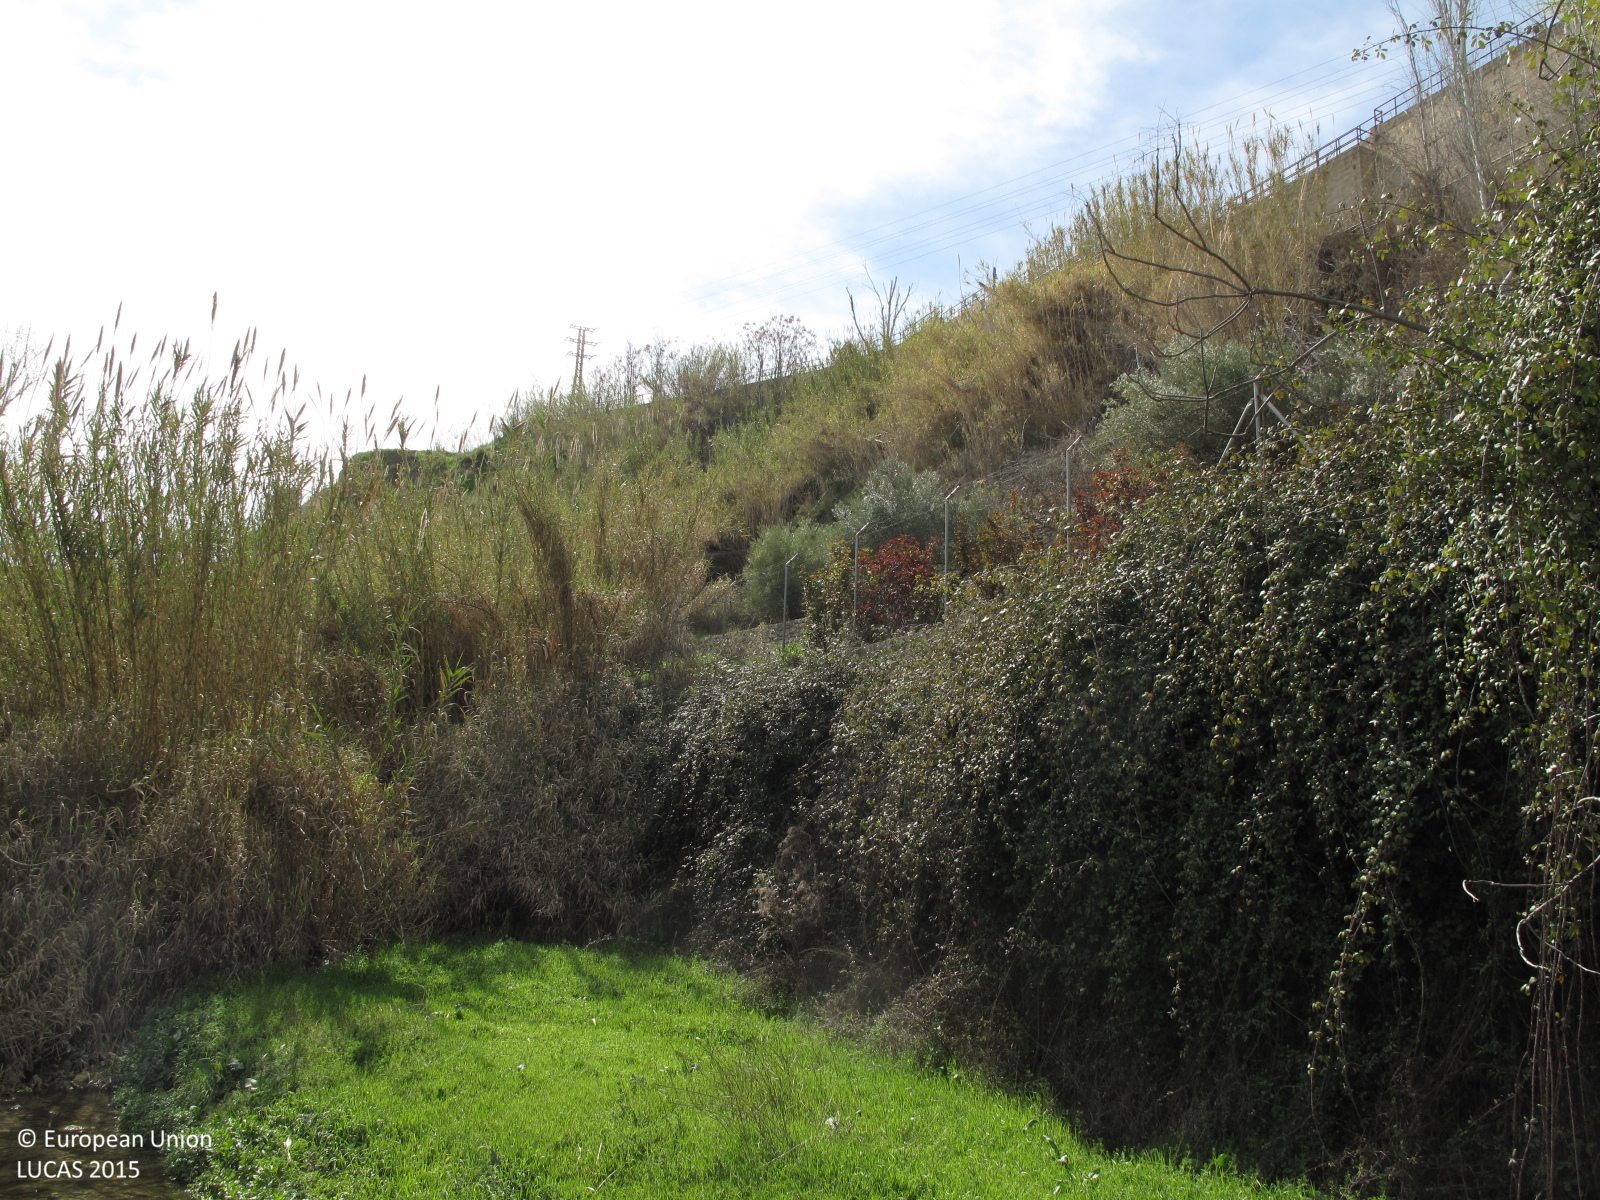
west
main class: Grassland
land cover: Grassland with sparse tree/shrub cover
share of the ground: > 75 %
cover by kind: herbaceous plants 90 %, broadleaved forest trees 5 %, shrubs 5 %
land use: Semi-natural and natural areas not in use
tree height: < 5 m
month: March
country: ES
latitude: 38.7028
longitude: -0.4647
